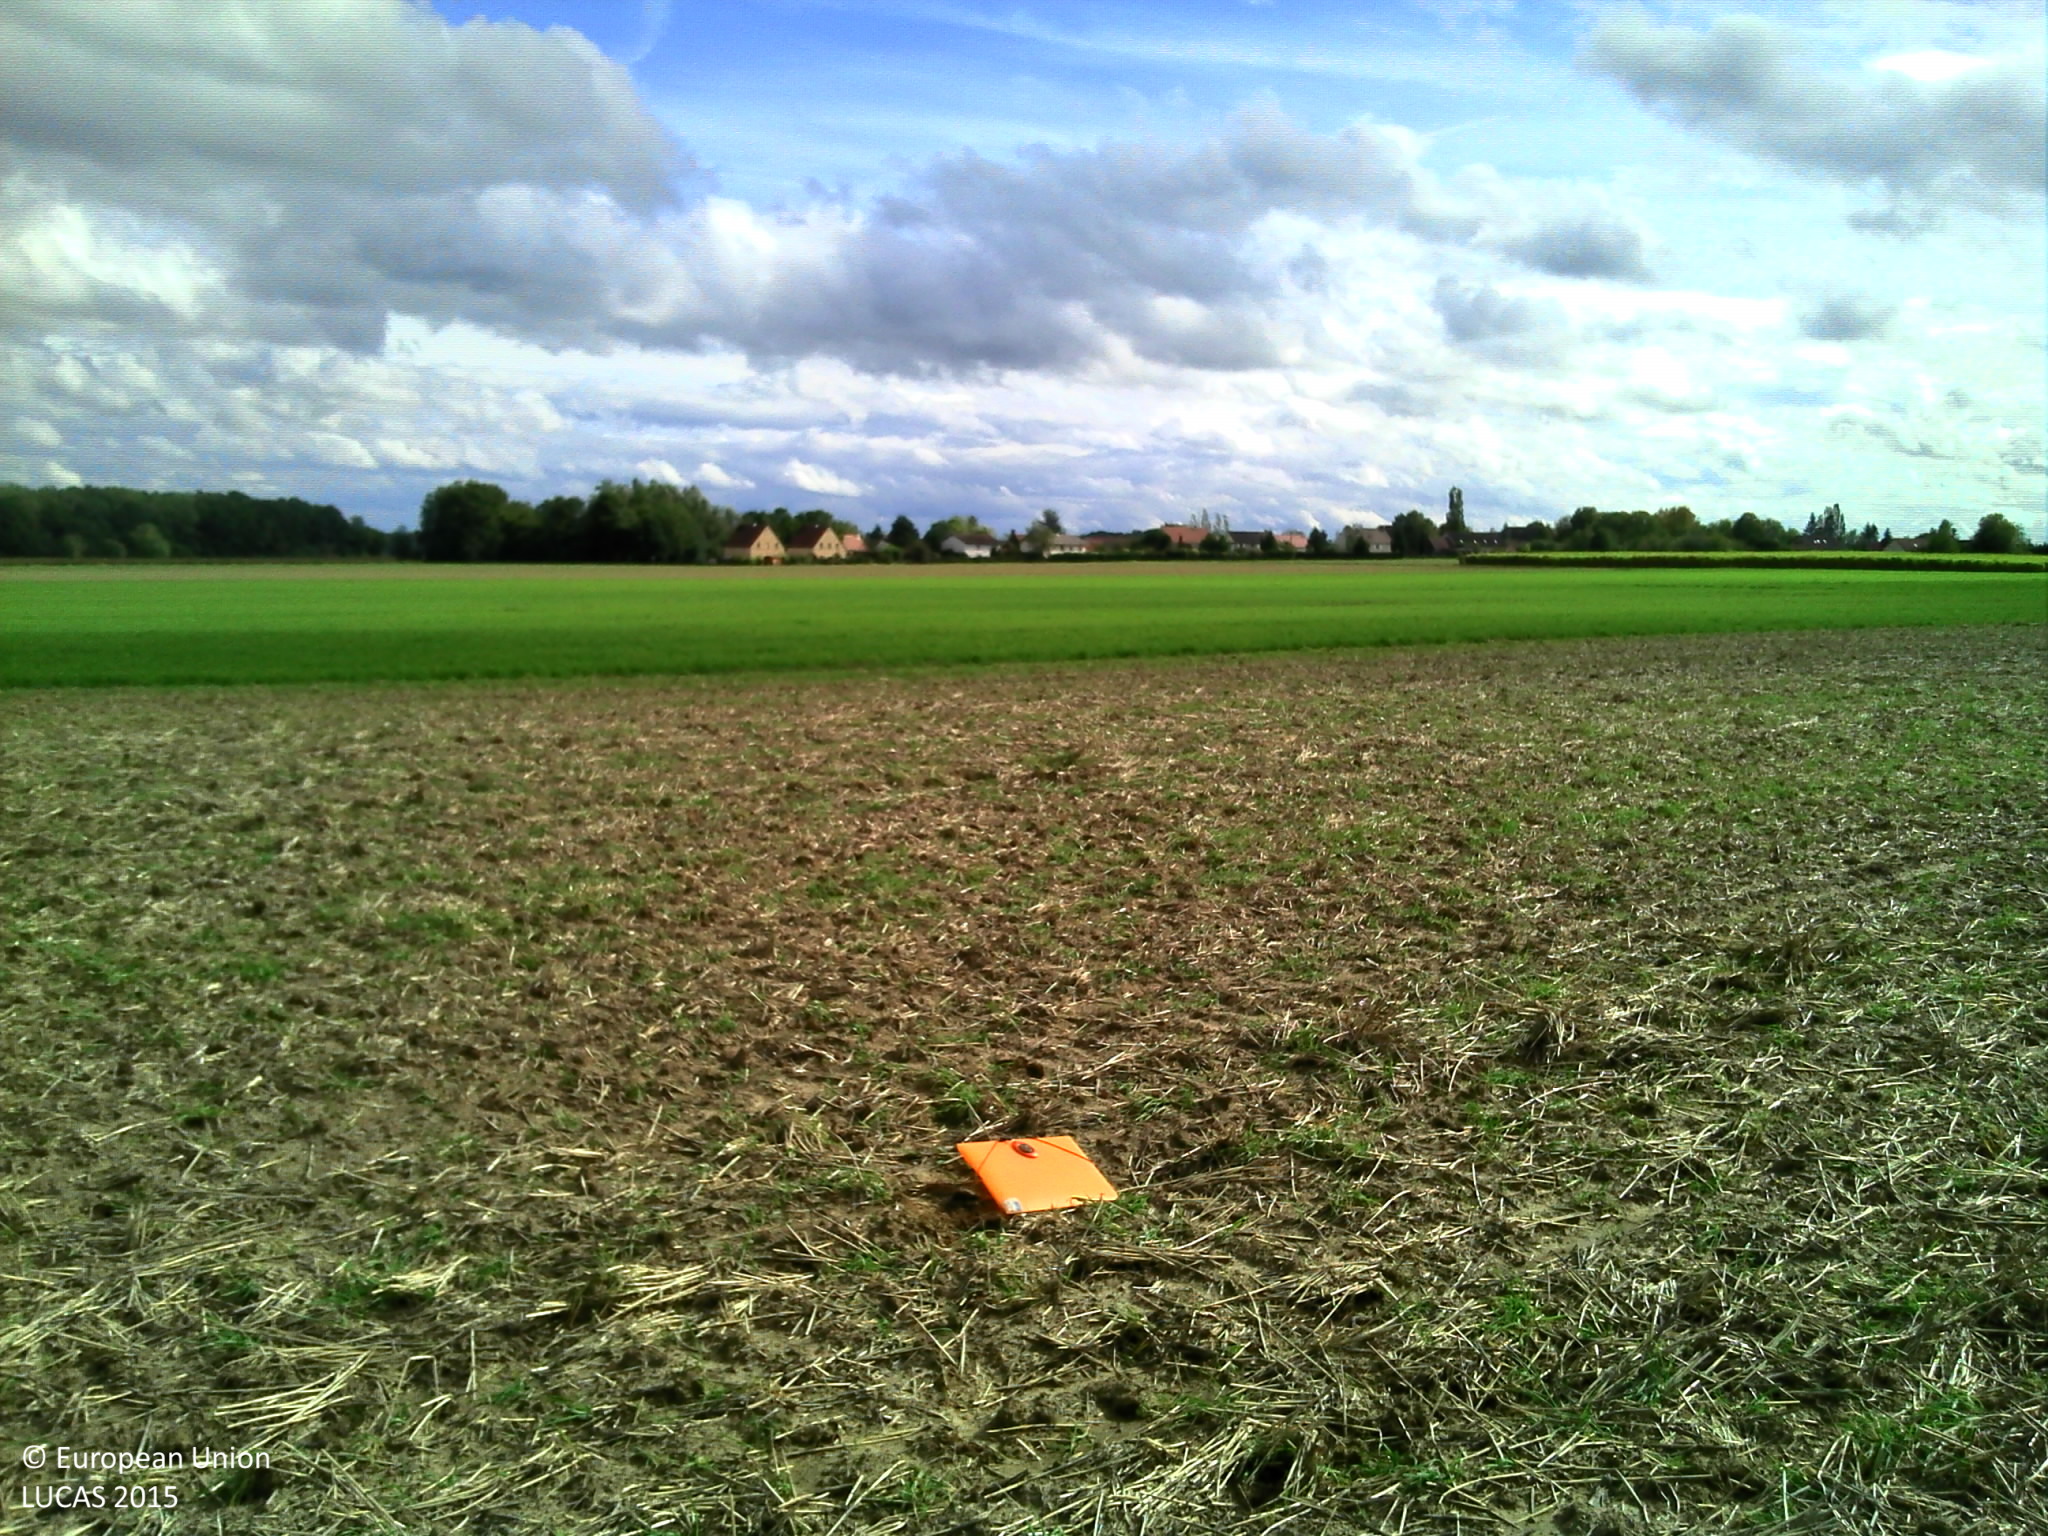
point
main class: Grassland
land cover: Spontaneously vegetated surfaces
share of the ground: 25 - 50 %
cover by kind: unconsolidated bare surface 60 %, herbaceous plants 40 %
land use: Agriculture (excluding fallow land and kitchen gardens)
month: September
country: FR
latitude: 47.1006
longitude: 5.0072
